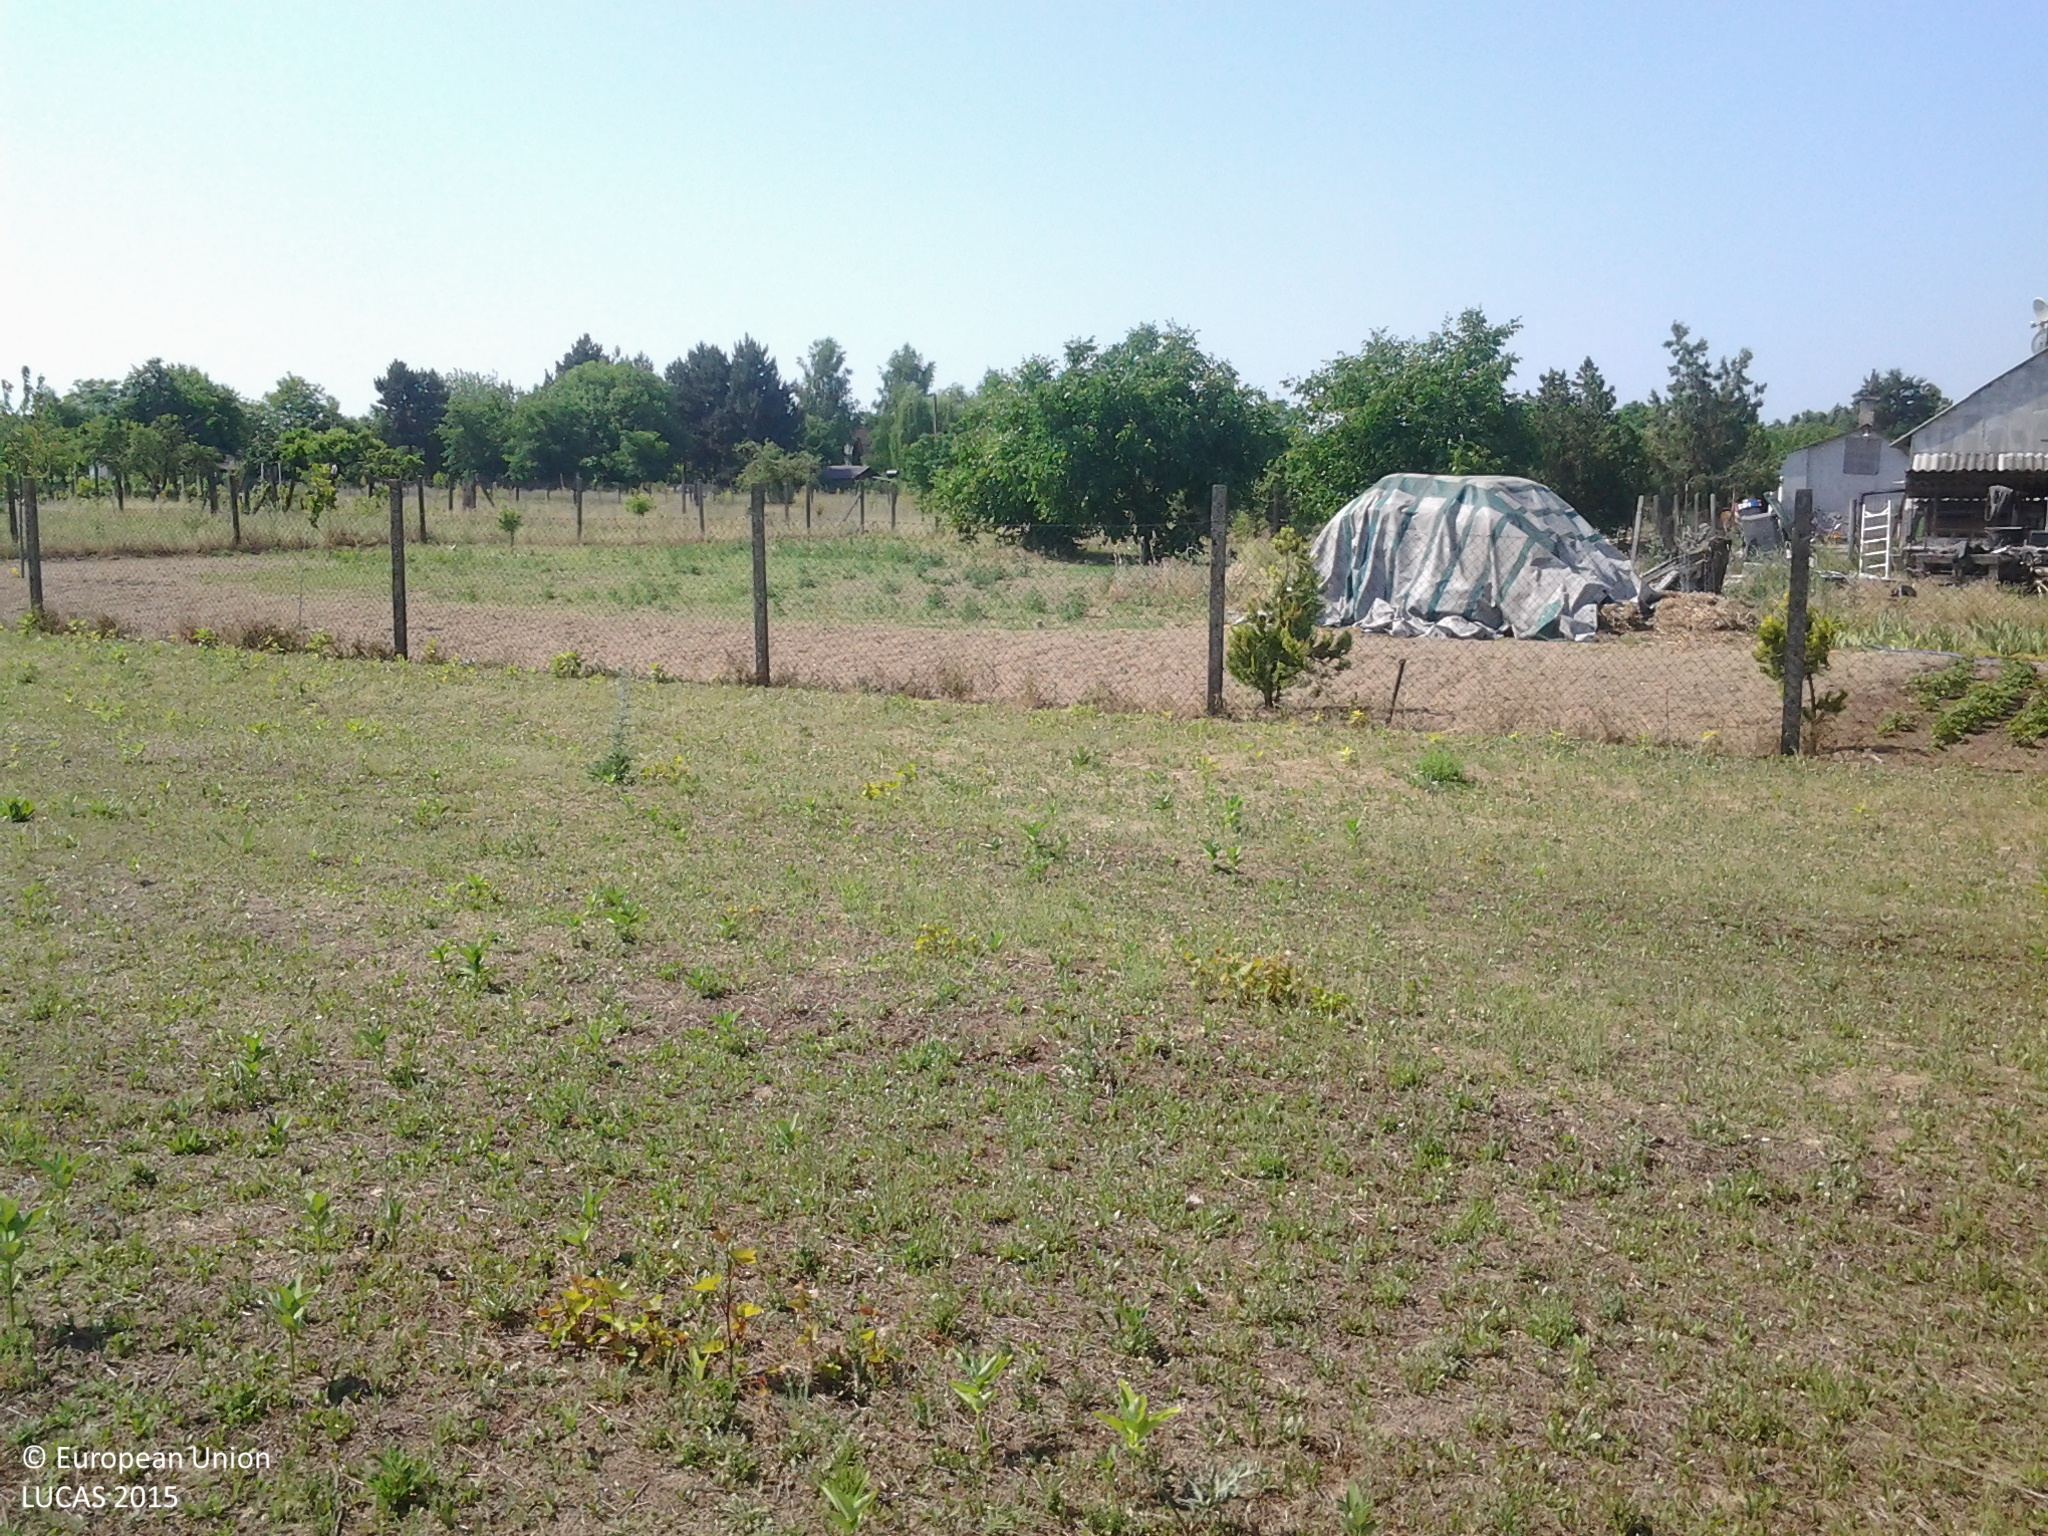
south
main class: Grassland
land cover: Spontaneously vegetated surfaces
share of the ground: > 75 %
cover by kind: herbaceous plants 95 %, unconsolidated bare surface 5 %
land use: Fallow land
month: June
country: HU
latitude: 46.9140
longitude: 19.6183
